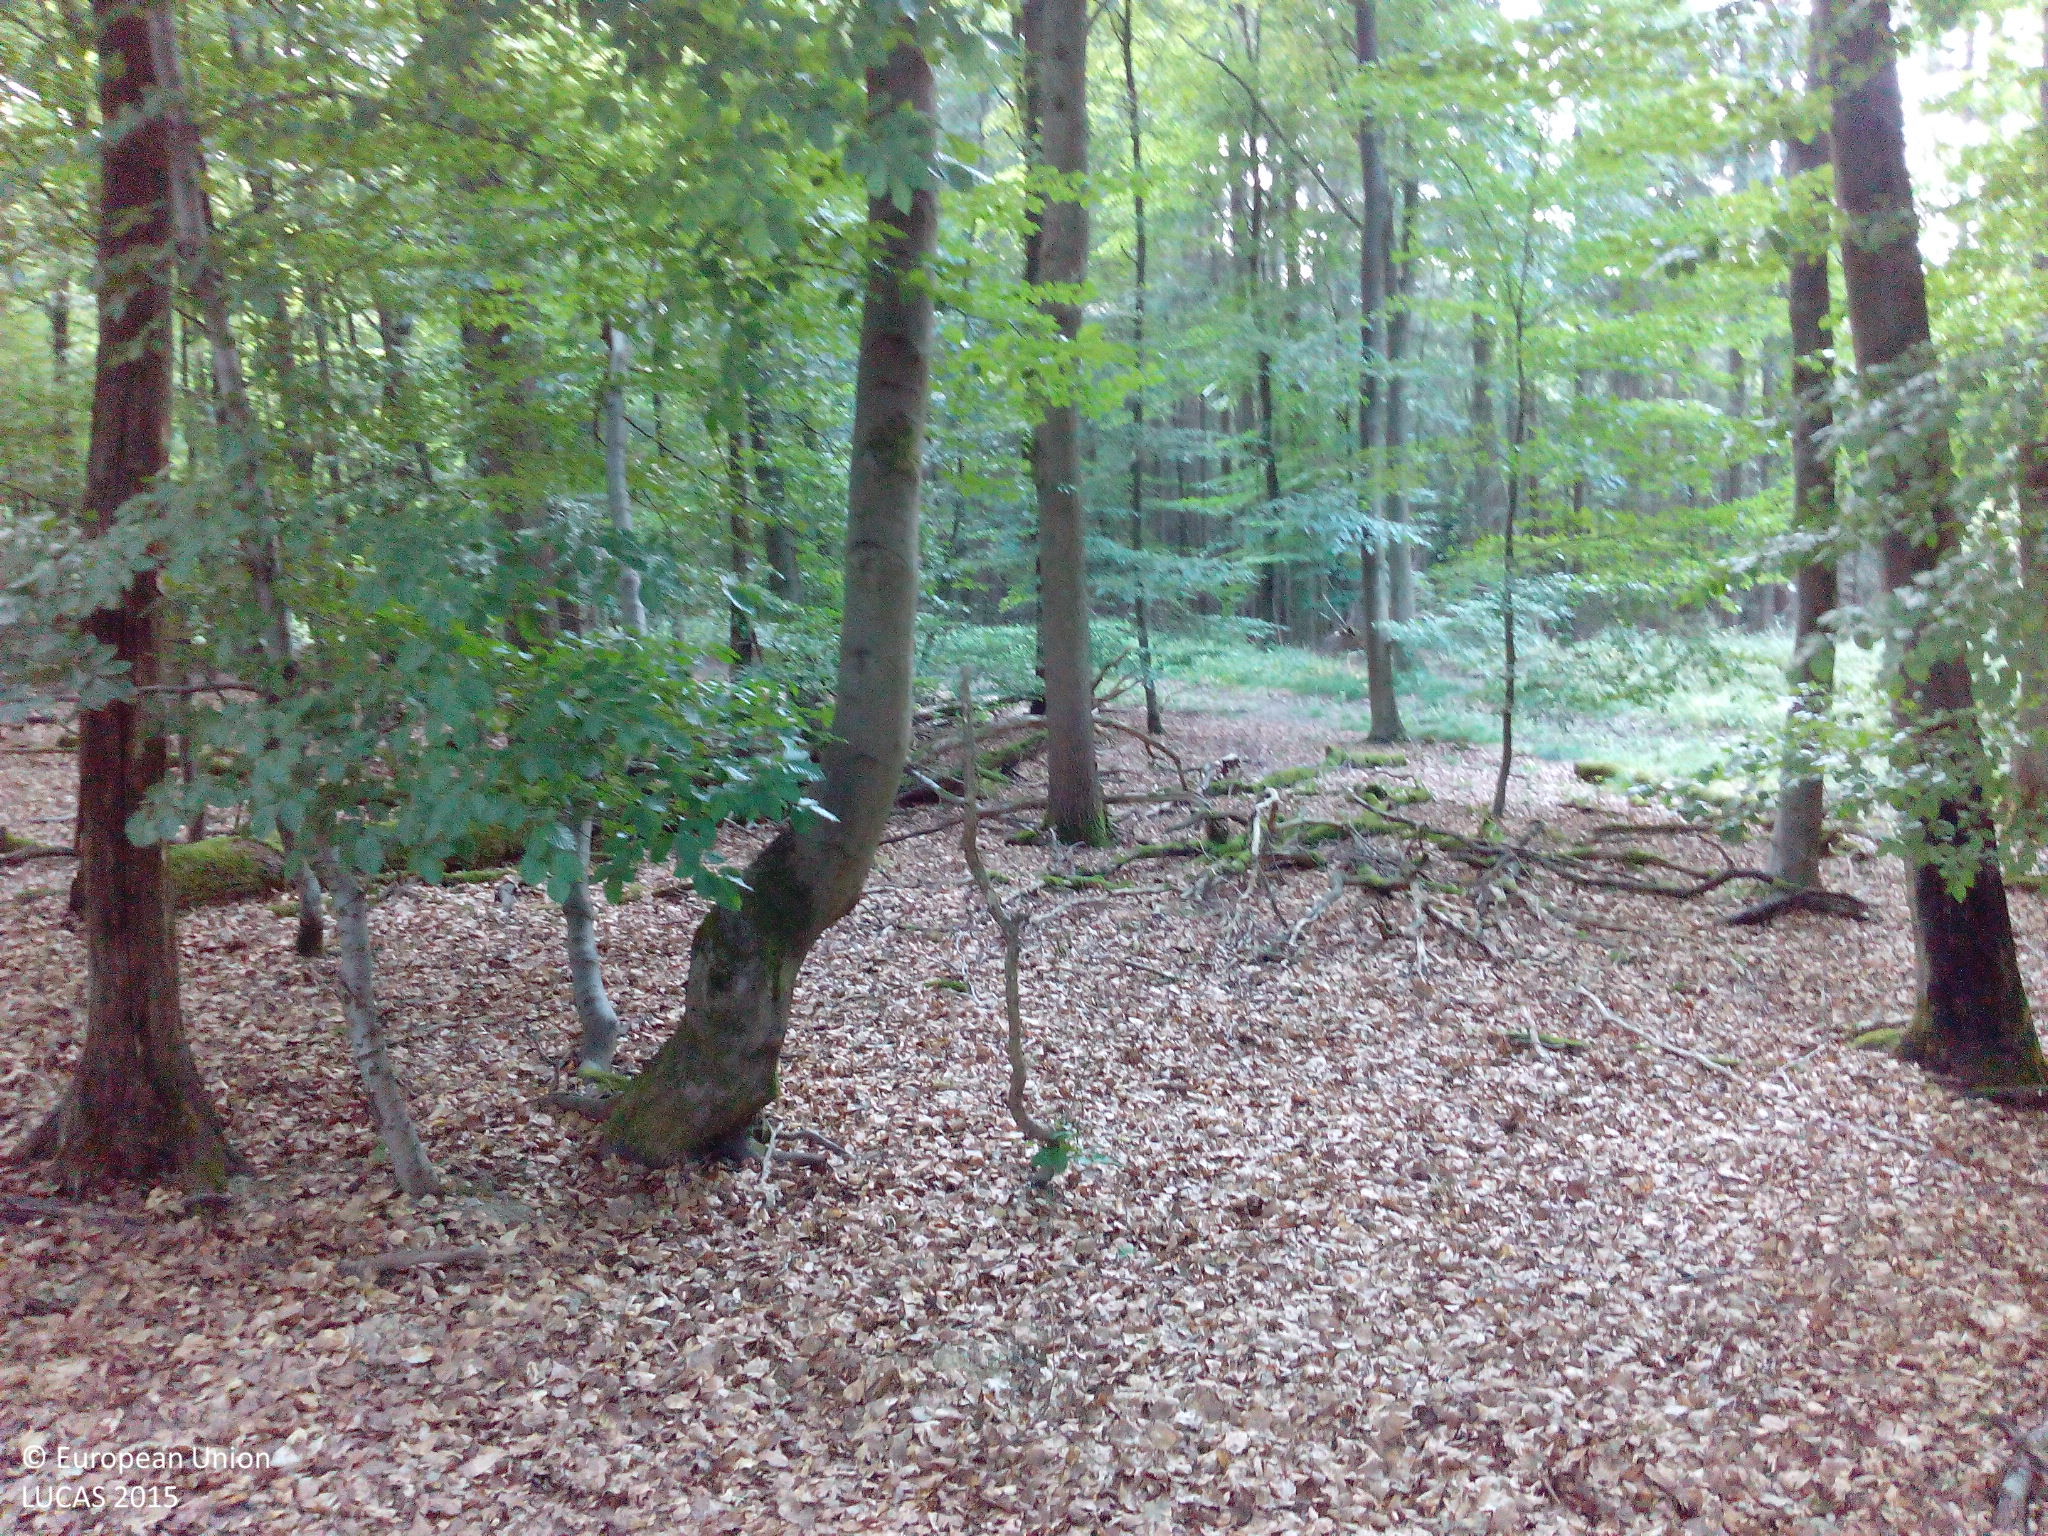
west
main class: Woodland
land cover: Broadleaved woodland
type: beech forest
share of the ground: > 75 %
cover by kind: broadleaved forest trees 90 %, unconsolidated bare surface 10 %
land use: Forestry
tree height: > 5 m
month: August
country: DE
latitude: 50.1034
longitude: 7.5256
